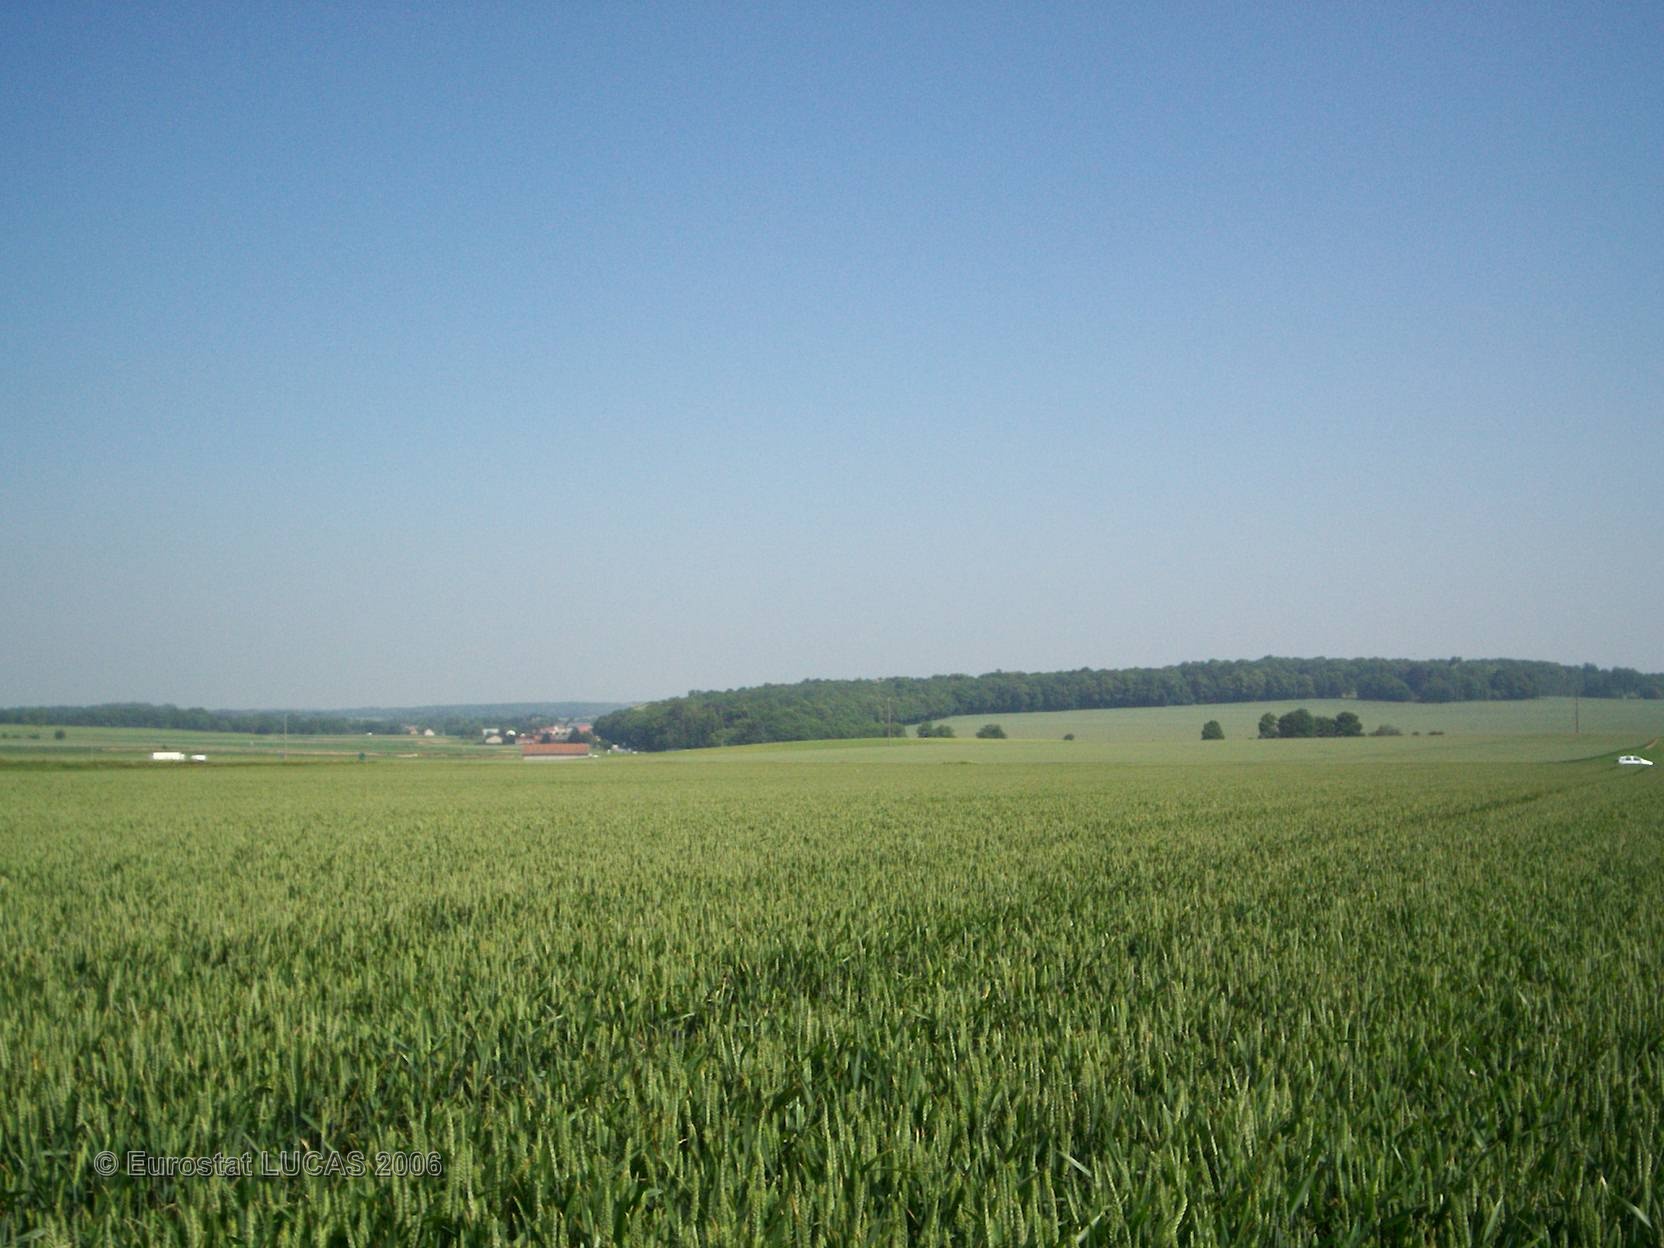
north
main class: Cropland
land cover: Common wheat
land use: Agriculture (excluding fallow land and kitchen gardens)
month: June
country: FR
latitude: 49.5352
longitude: 2.7070
